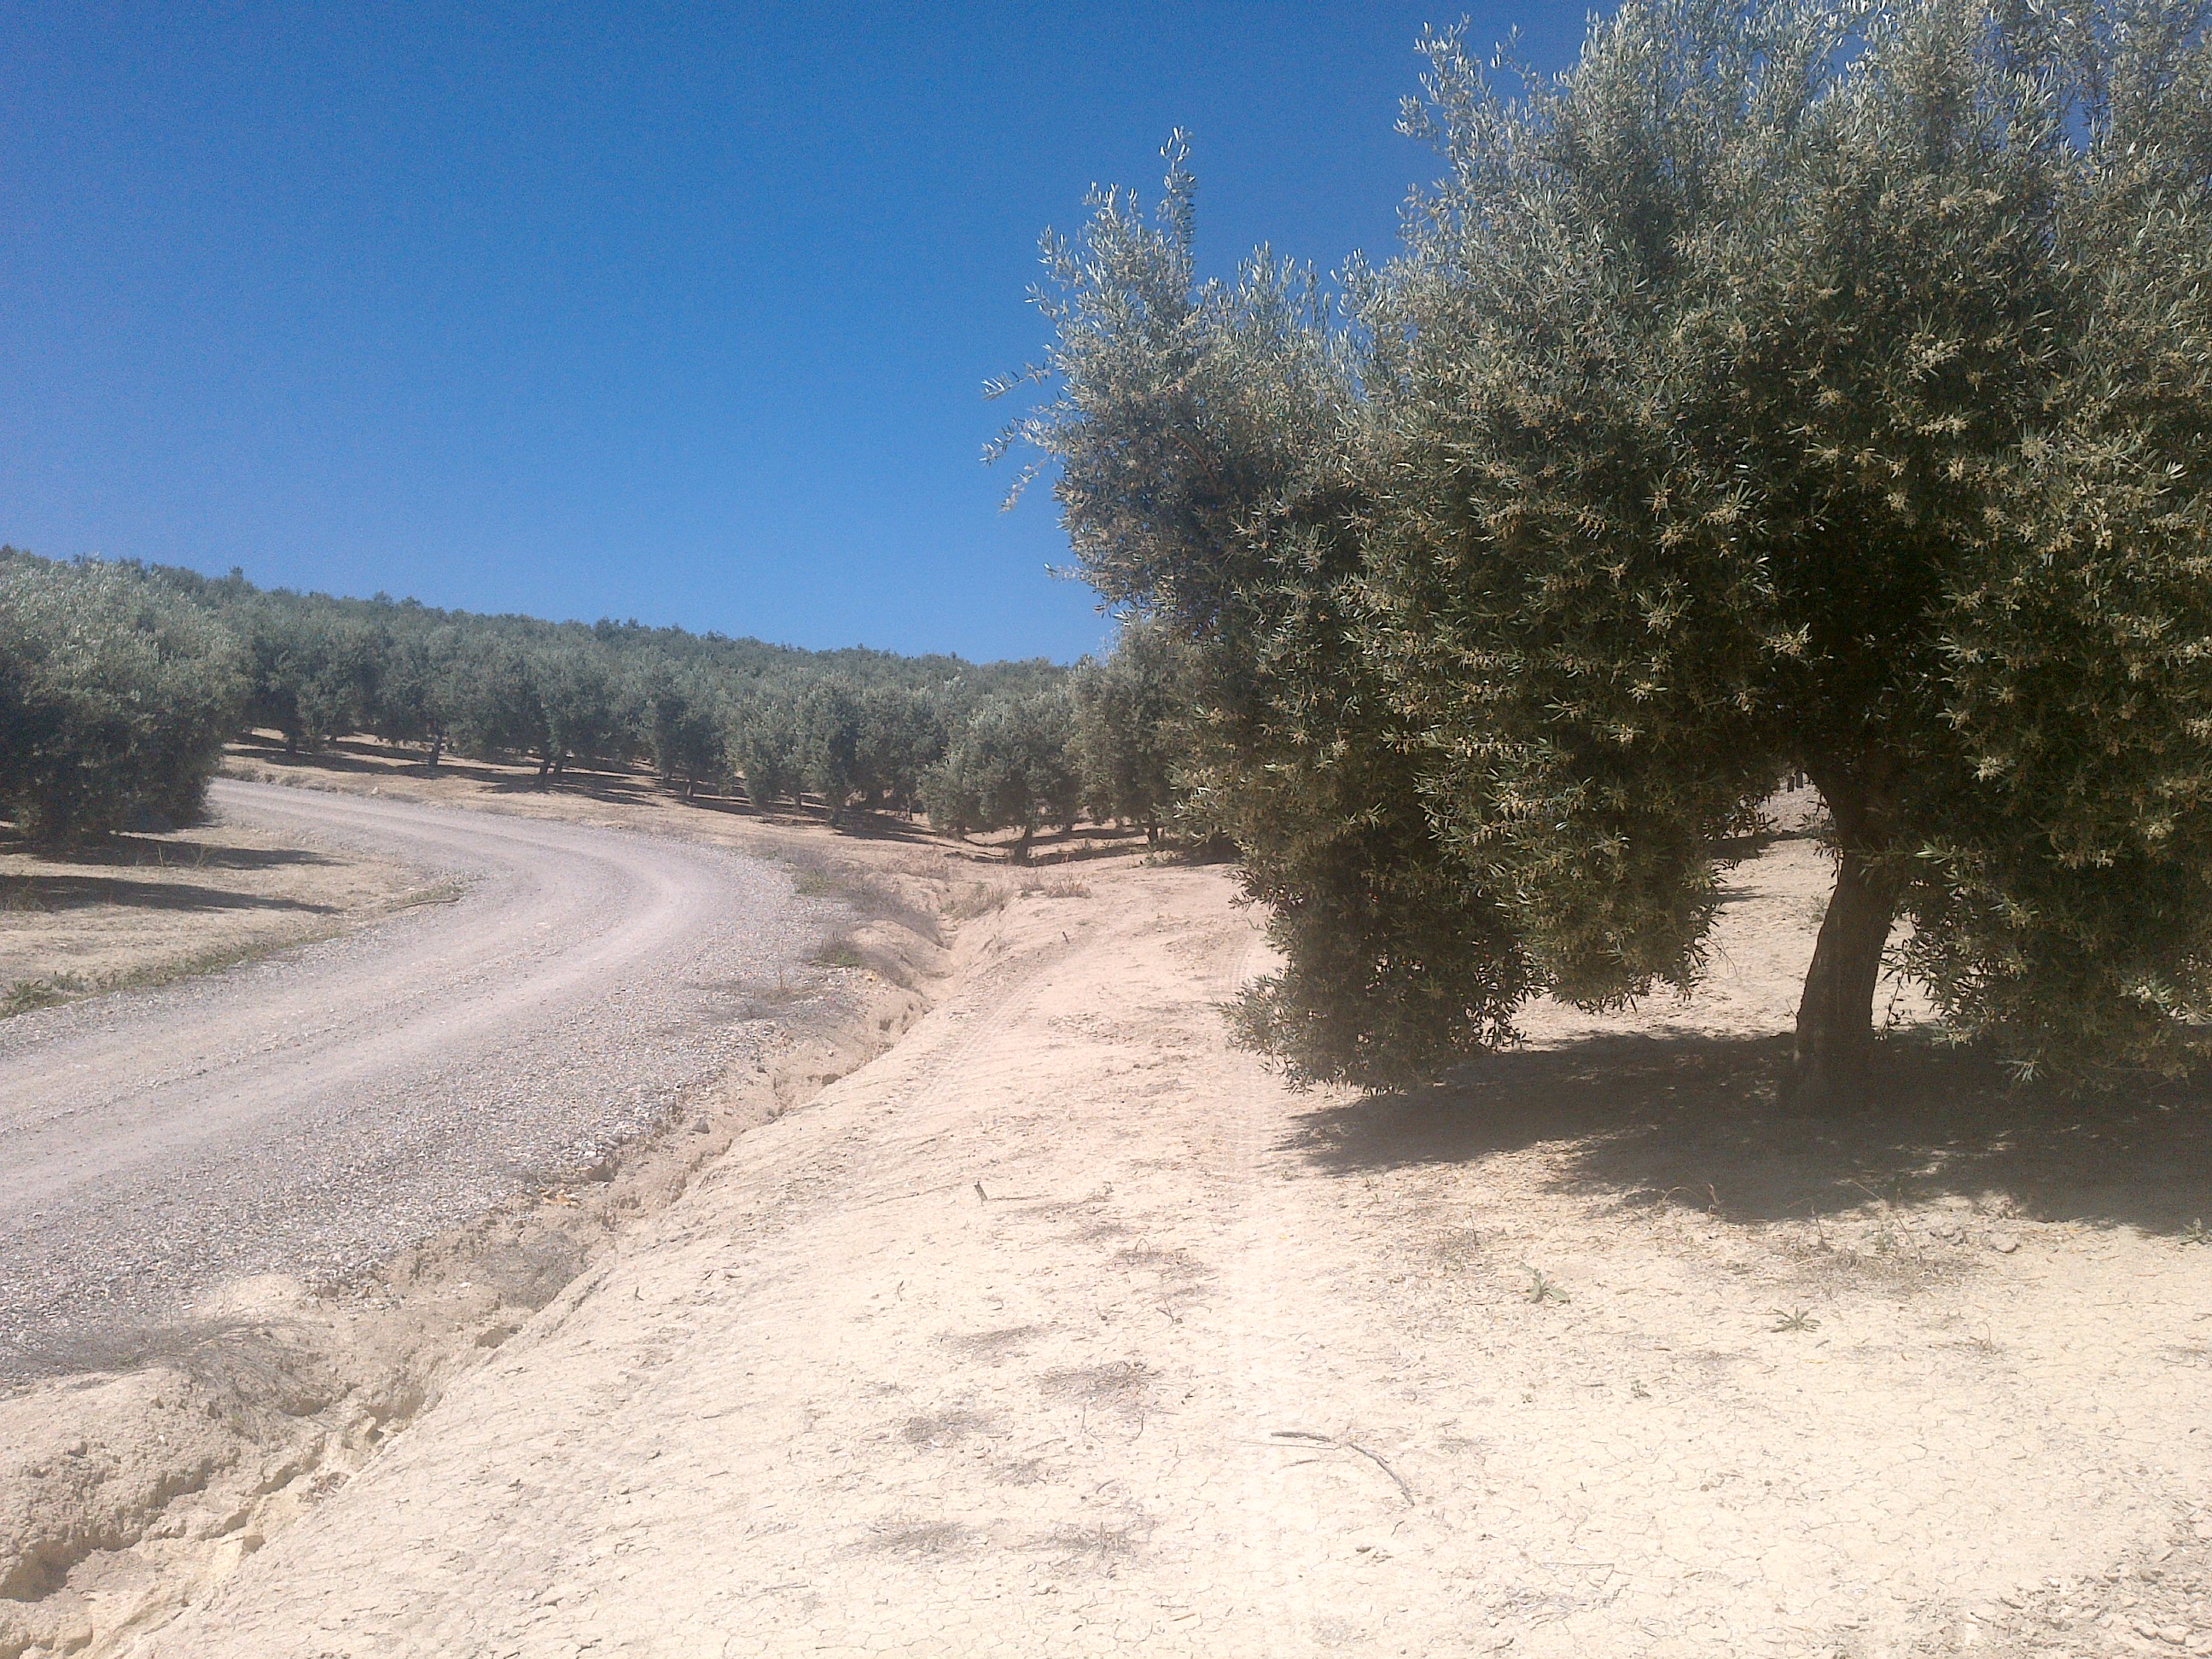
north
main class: Cropland
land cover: Olive groves
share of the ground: 50 - 75 %
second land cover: Other bare soil
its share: > 75 %
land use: Agriculture (excluding fallow land and kitchen gardens)
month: May
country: ES
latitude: 37.7694
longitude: -4.6210
